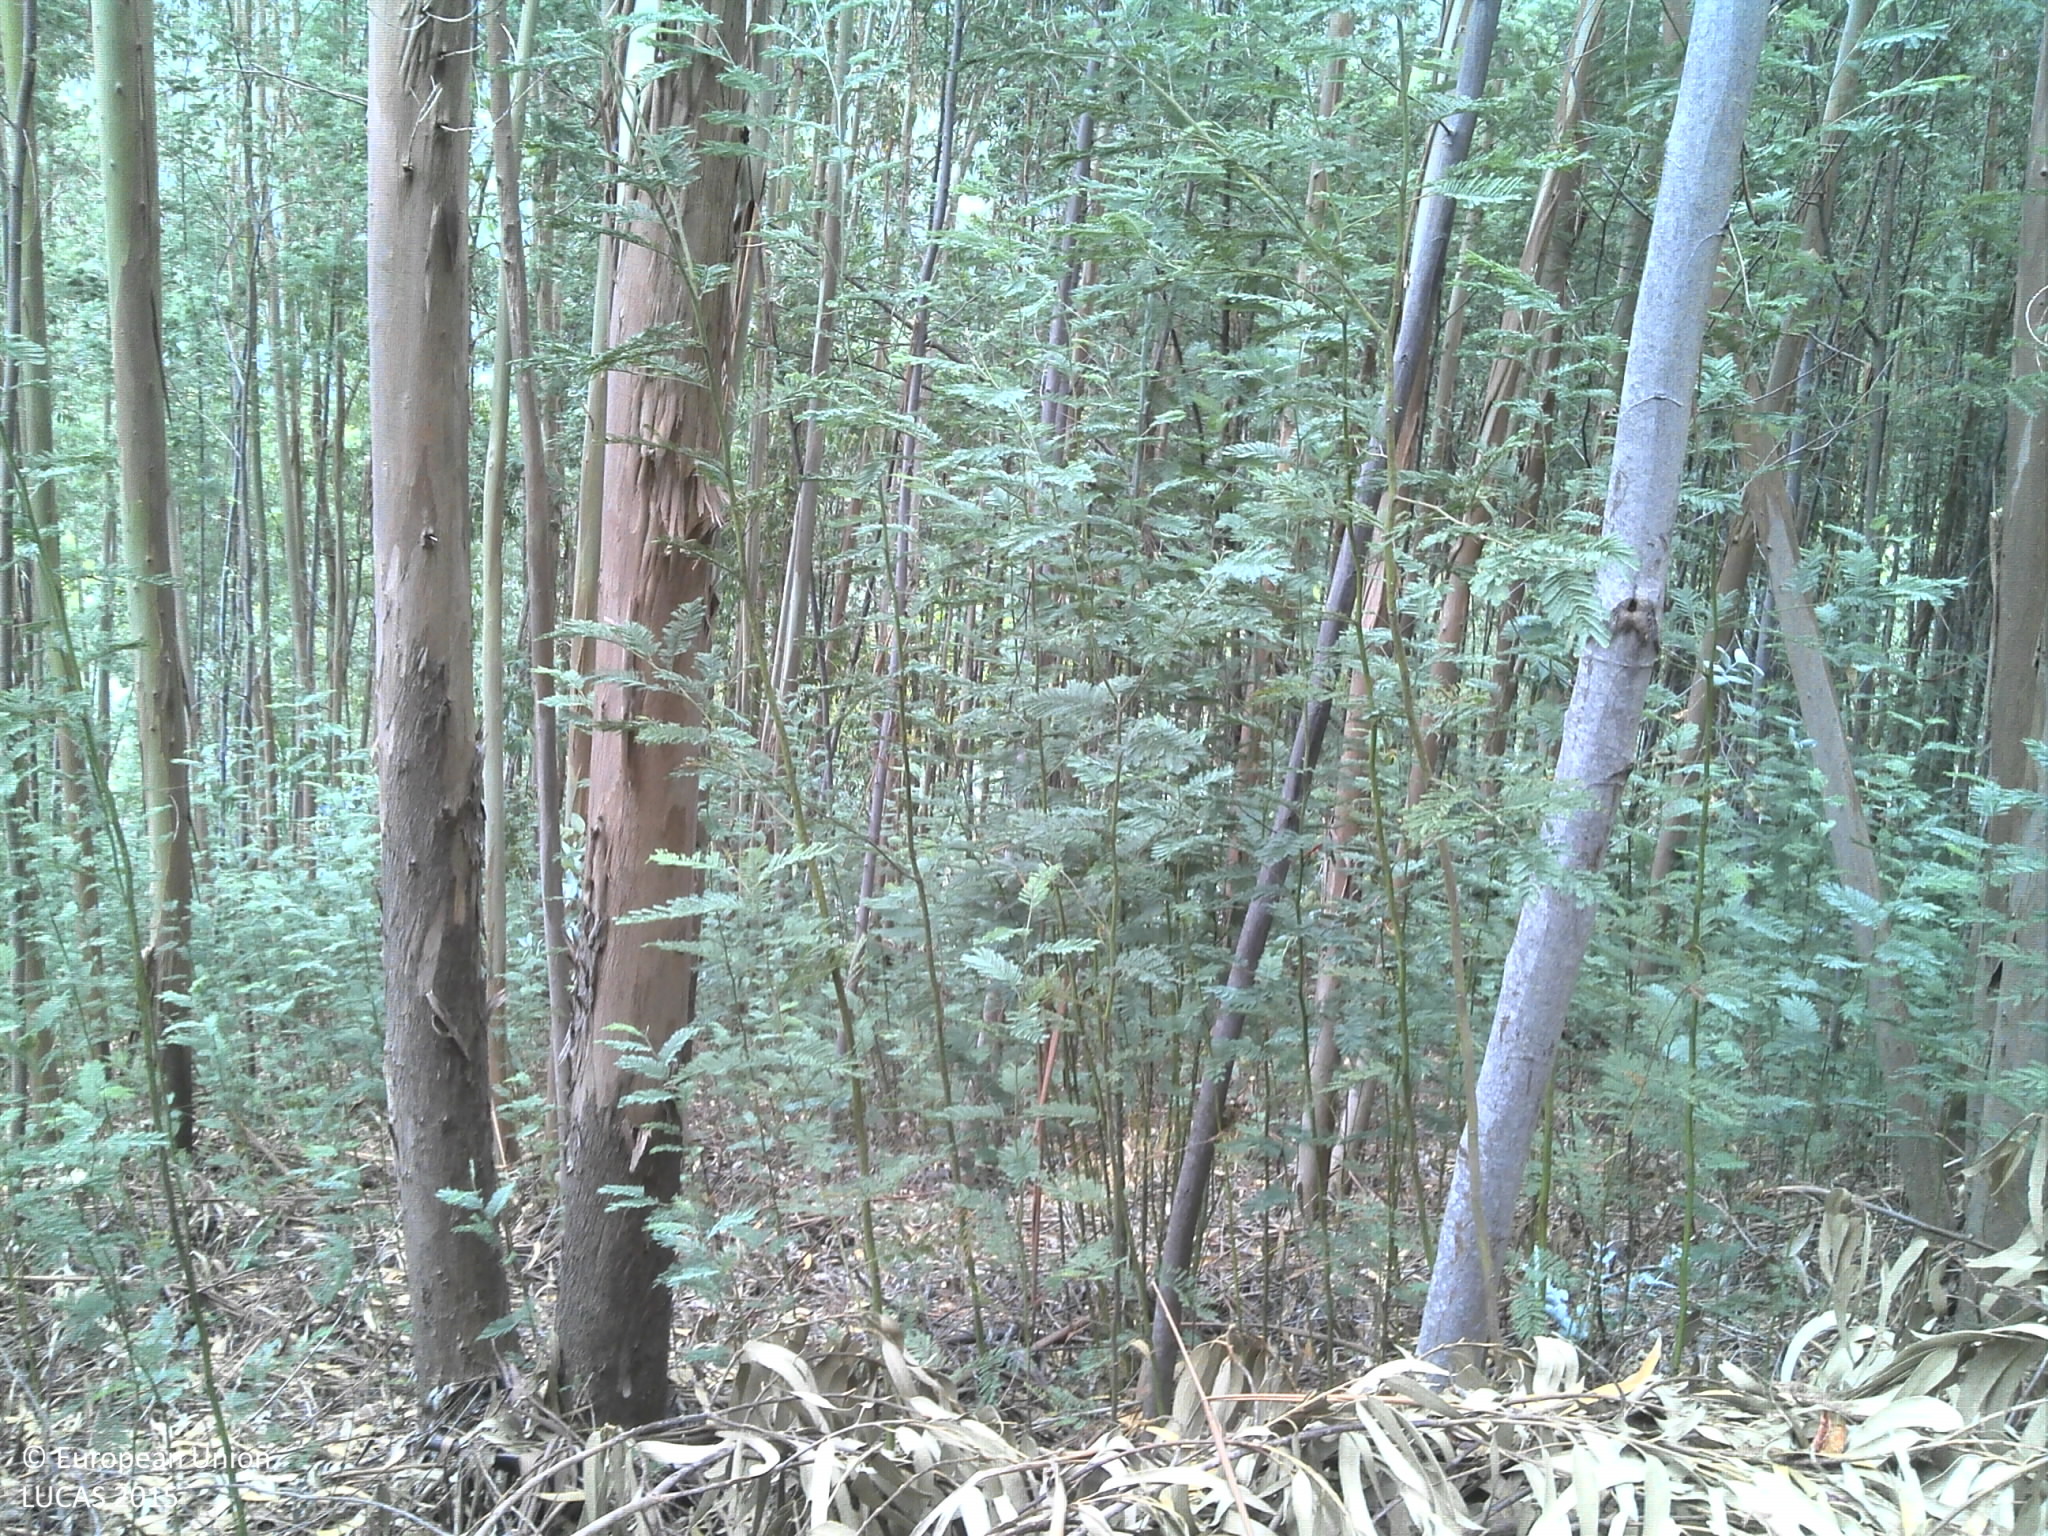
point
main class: Woodland
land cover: Broadleaved woodland
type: exotic forest
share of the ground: 50 - 75 %
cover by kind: broadleaved forest trees 60 %, unconsolidated bare surface 25 %, shrubs 15 %
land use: Forestry
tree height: > 5 m
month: July
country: PT
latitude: 40.2683
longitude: -8.2963
